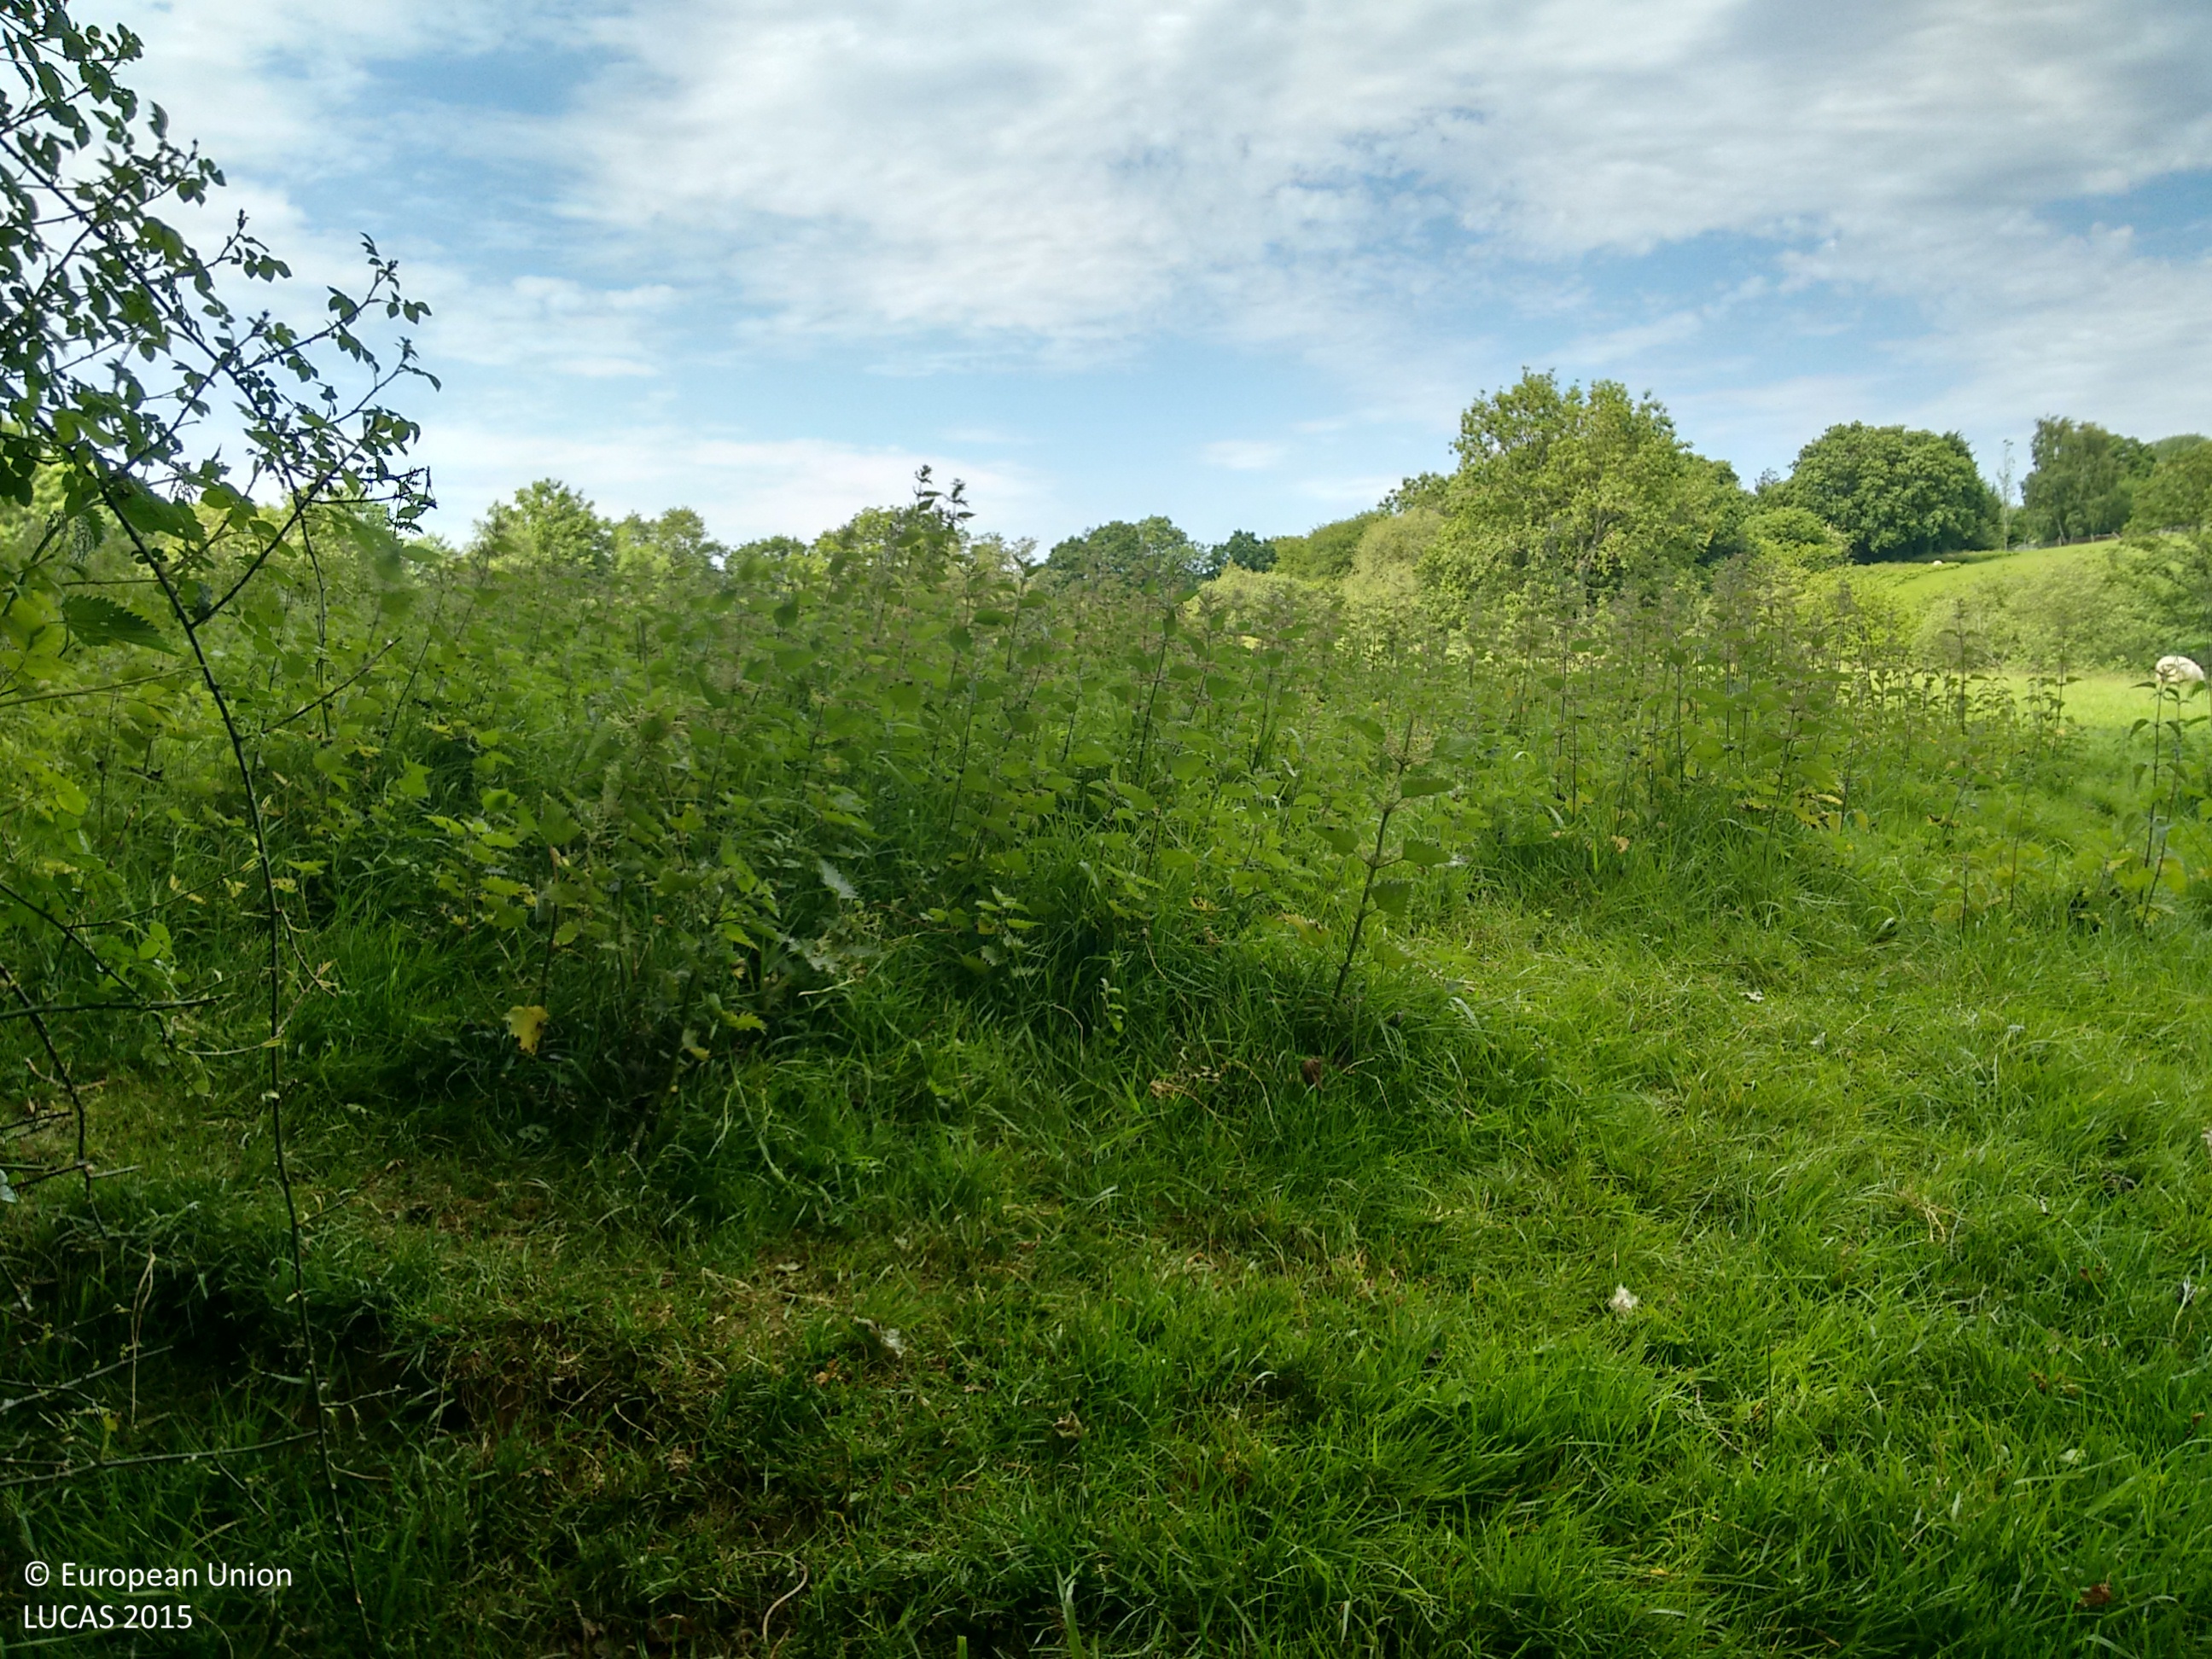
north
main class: Grassland
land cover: Grassland without tree/shrub cover
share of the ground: > 75 %
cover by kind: herbaceous plants 100 %
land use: Agriculture (excluding fallow land and kitchen gardens)
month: June
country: GB
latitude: 51.0824
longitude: 0.6231
